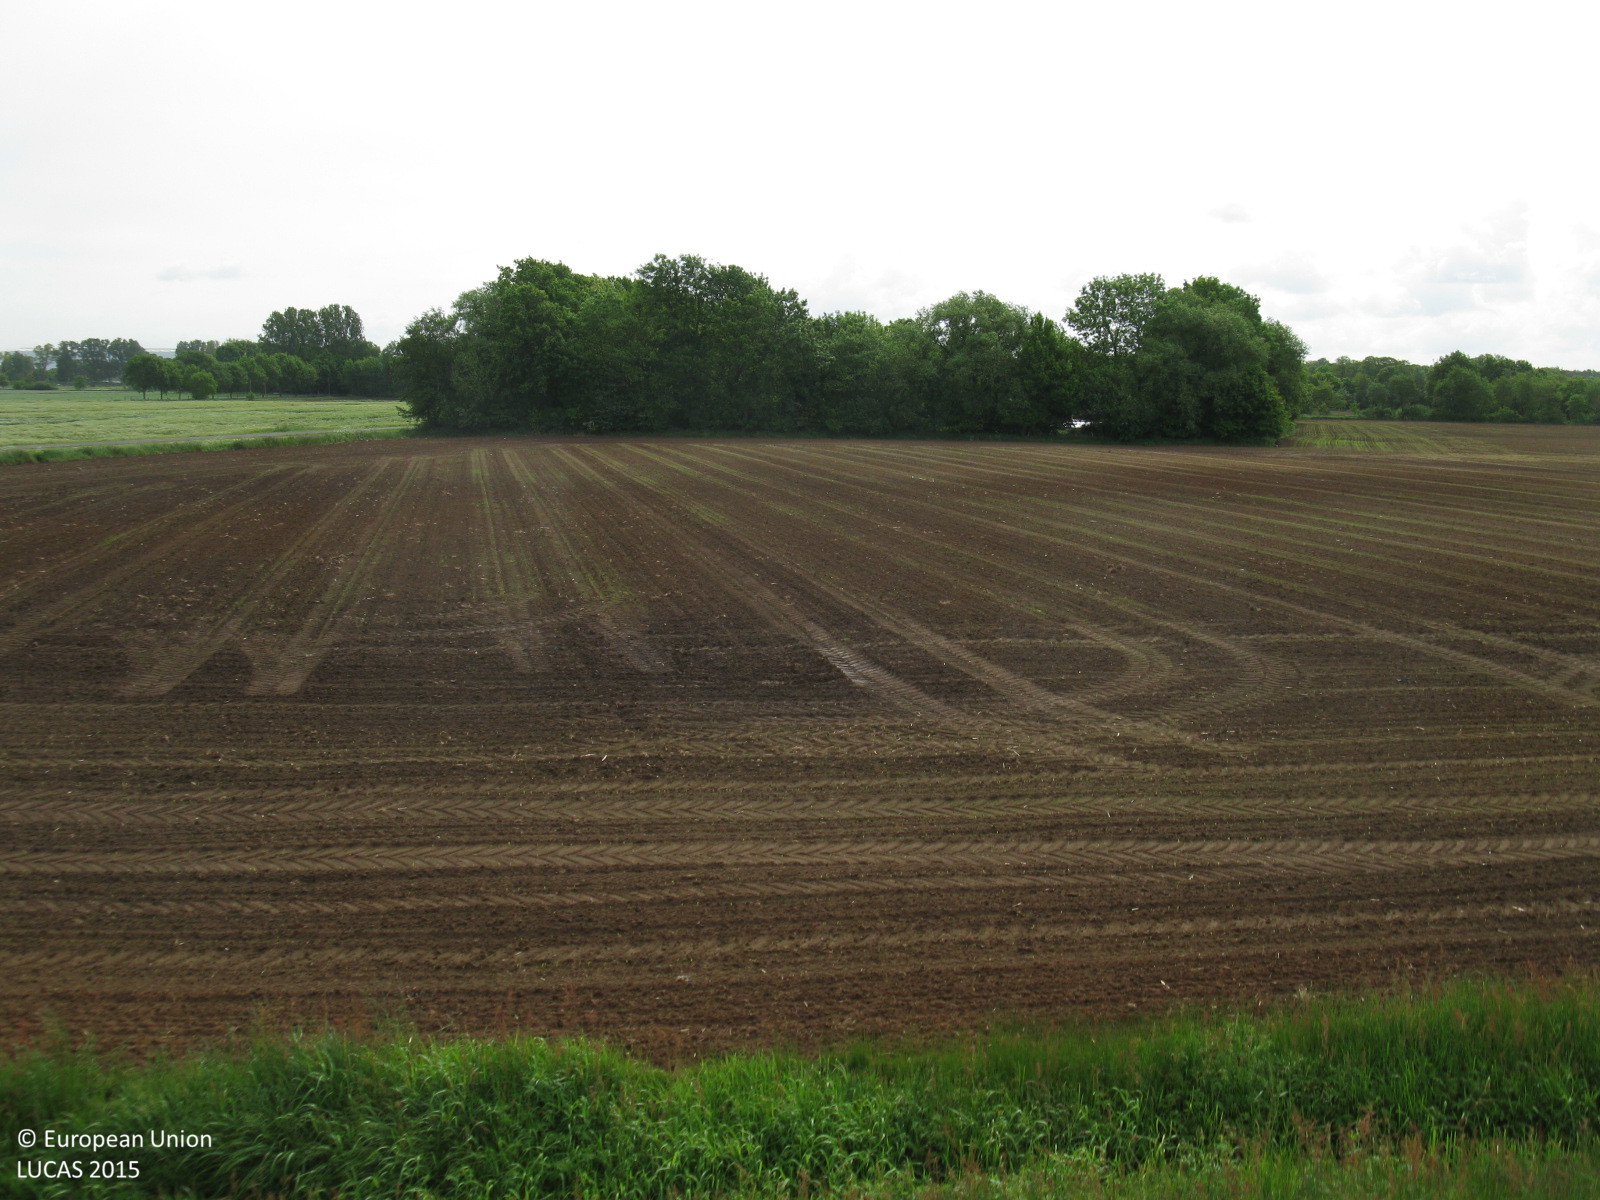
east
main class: Grassland
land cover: Grassland without tree/shrub cover
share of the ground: > 75 %
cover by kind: herbaceous plants 100 %
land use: Protection infrastructures
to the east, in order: Grassland without tree/shrub cover; Ditches and canals; Grass margins; Maize; Broadleaved woodland; Spontaneously vegetated surfaces; Artificial constructions in urban areas
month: June
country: DE
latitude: 53.0841
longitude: 7.2982
